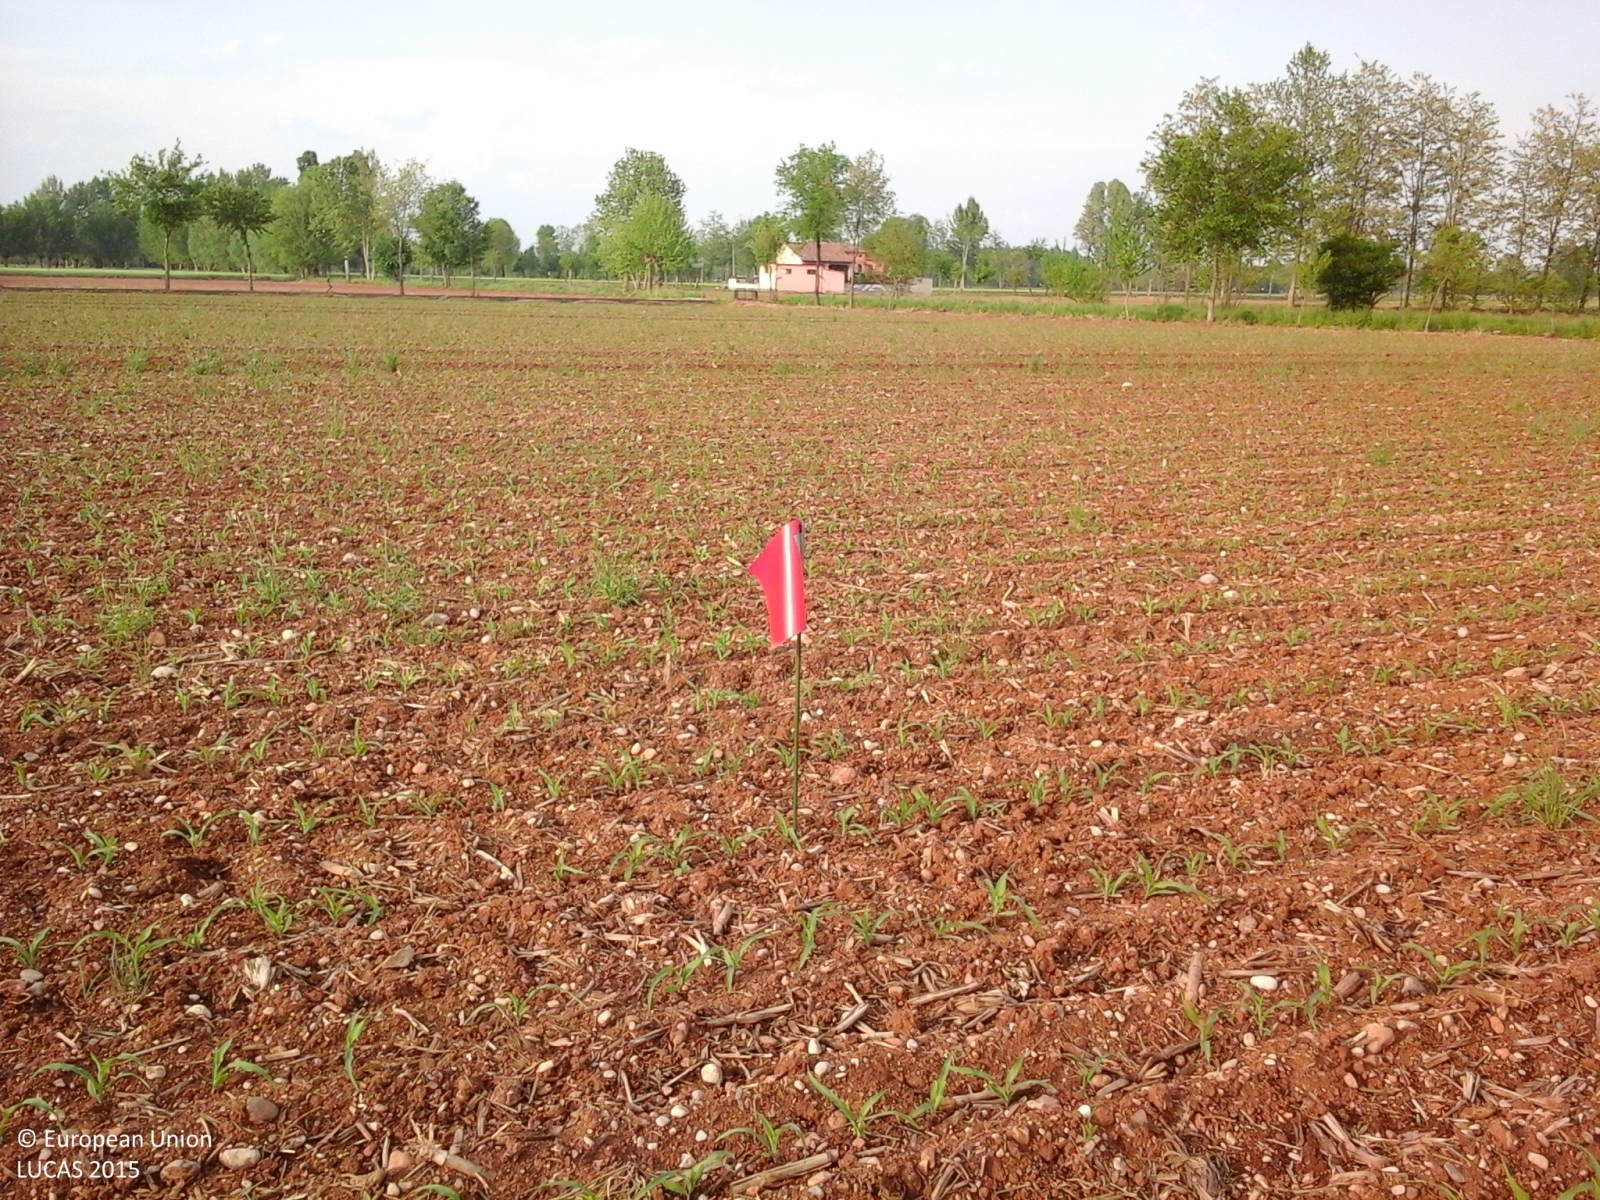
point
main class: Cropland
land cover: Maize
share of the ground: < 10 %
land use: Agriculture (excluding fallow land and kitchen gardens)
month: April
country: IT
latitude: 45.4134
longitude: 10.4209
